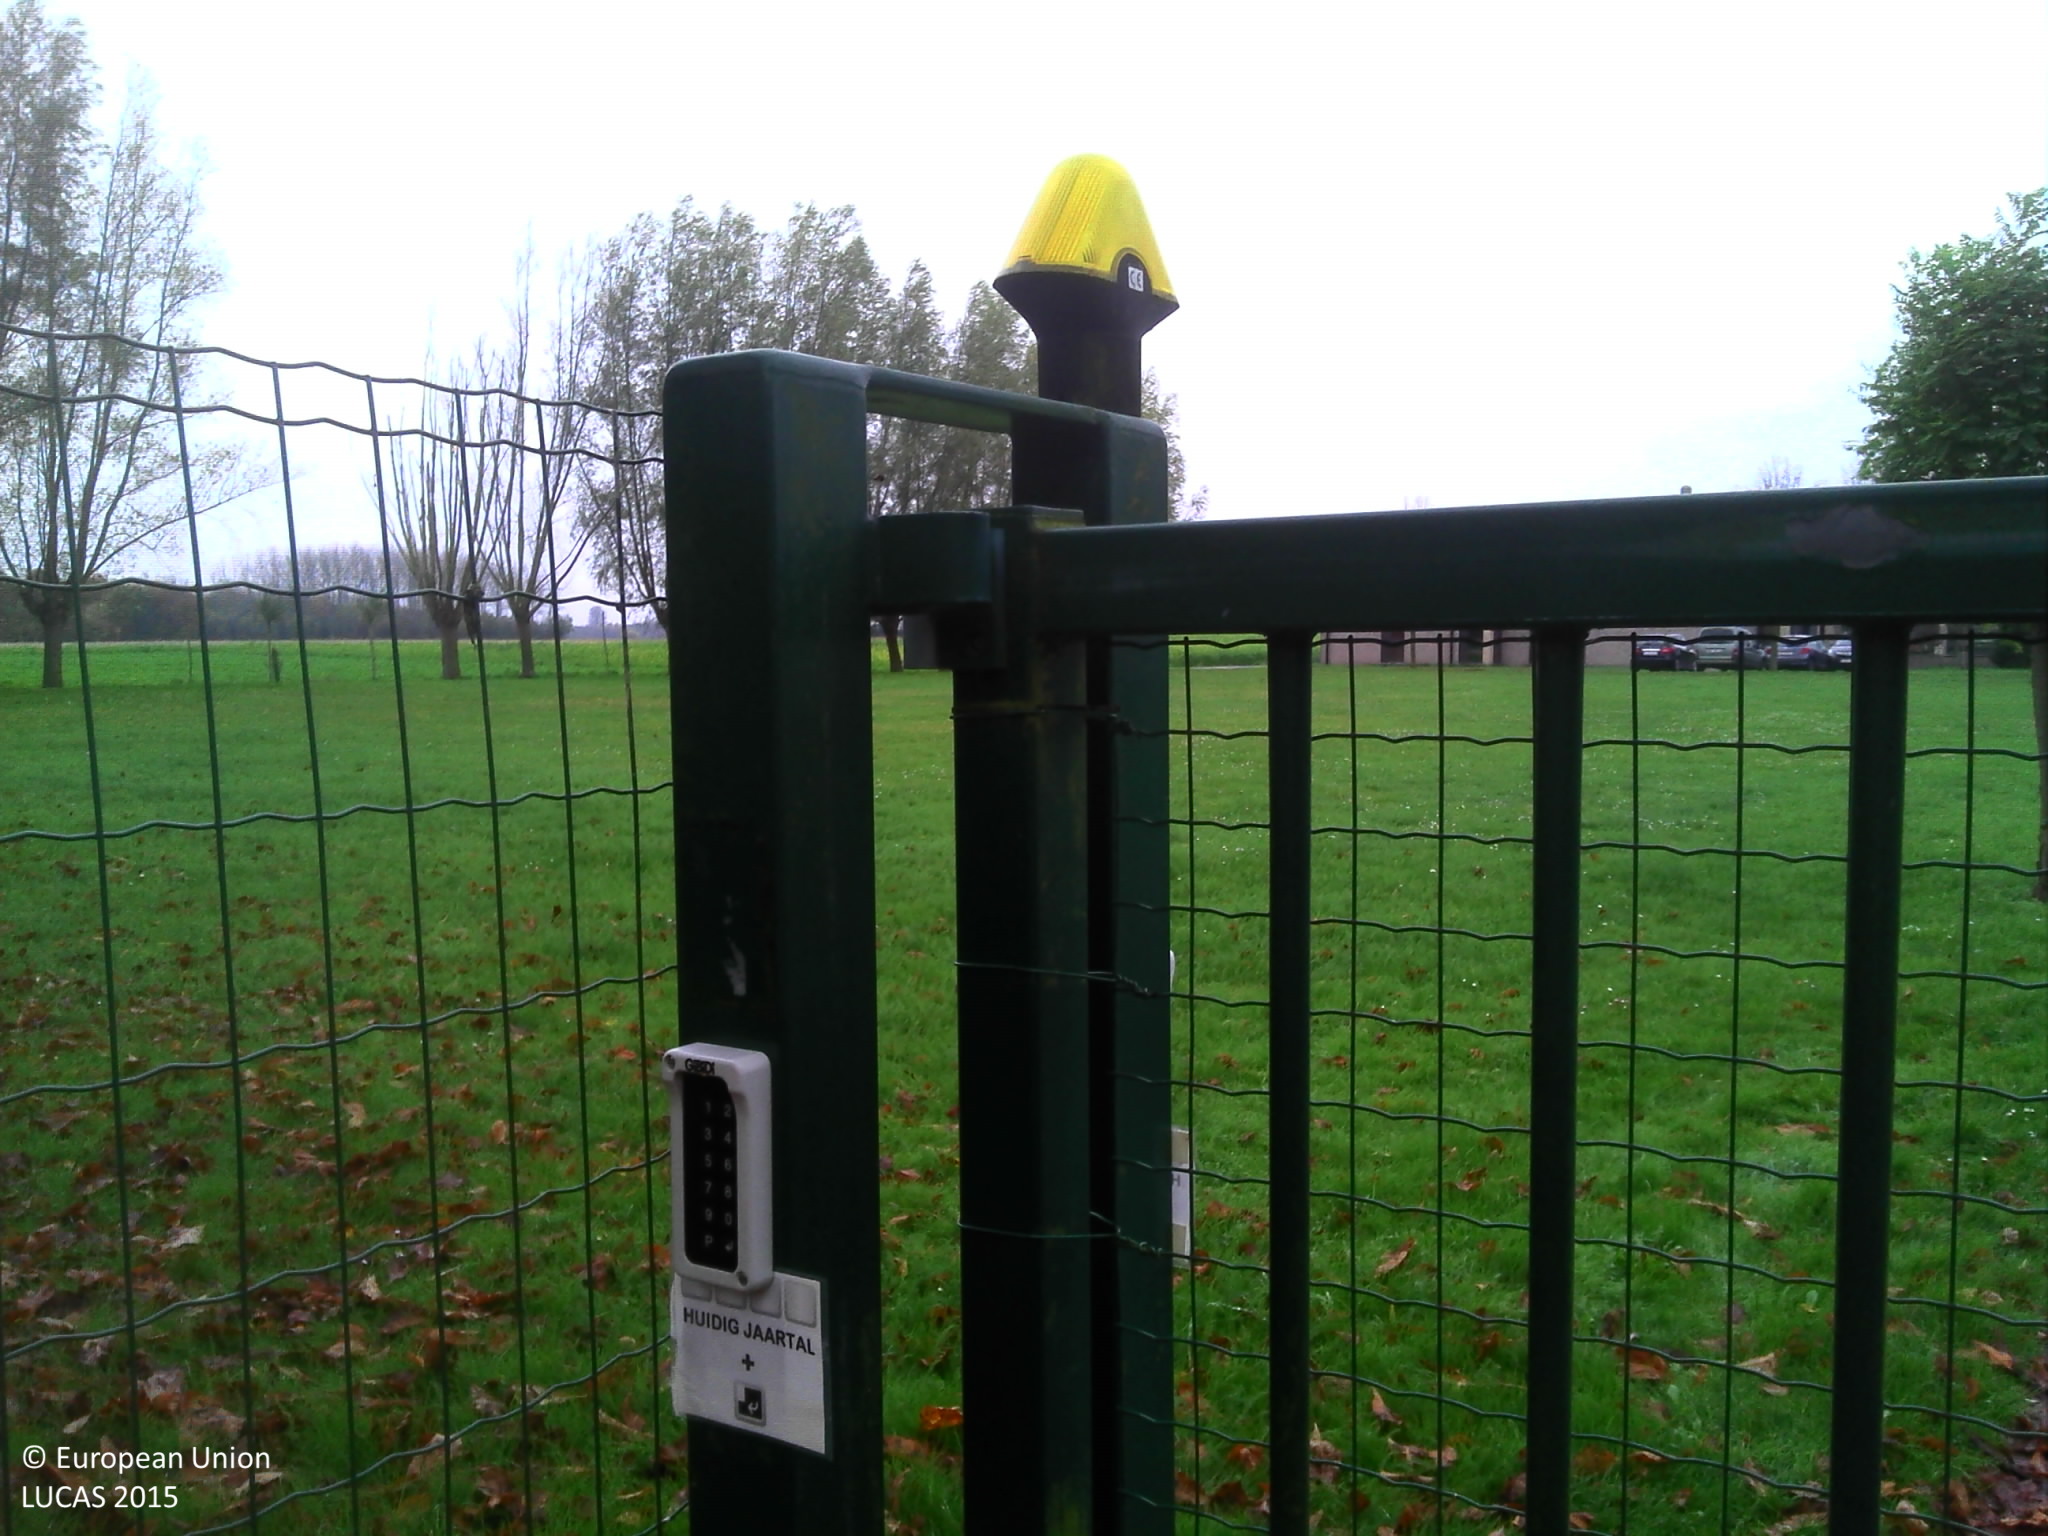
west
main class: Grassland
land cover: Grassland without tree/shrub cover
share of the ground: > 75 %
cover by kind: herbaceous plants 100 %
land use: Residential
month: November
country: BE
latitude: 51.1050
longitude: 4.2966
